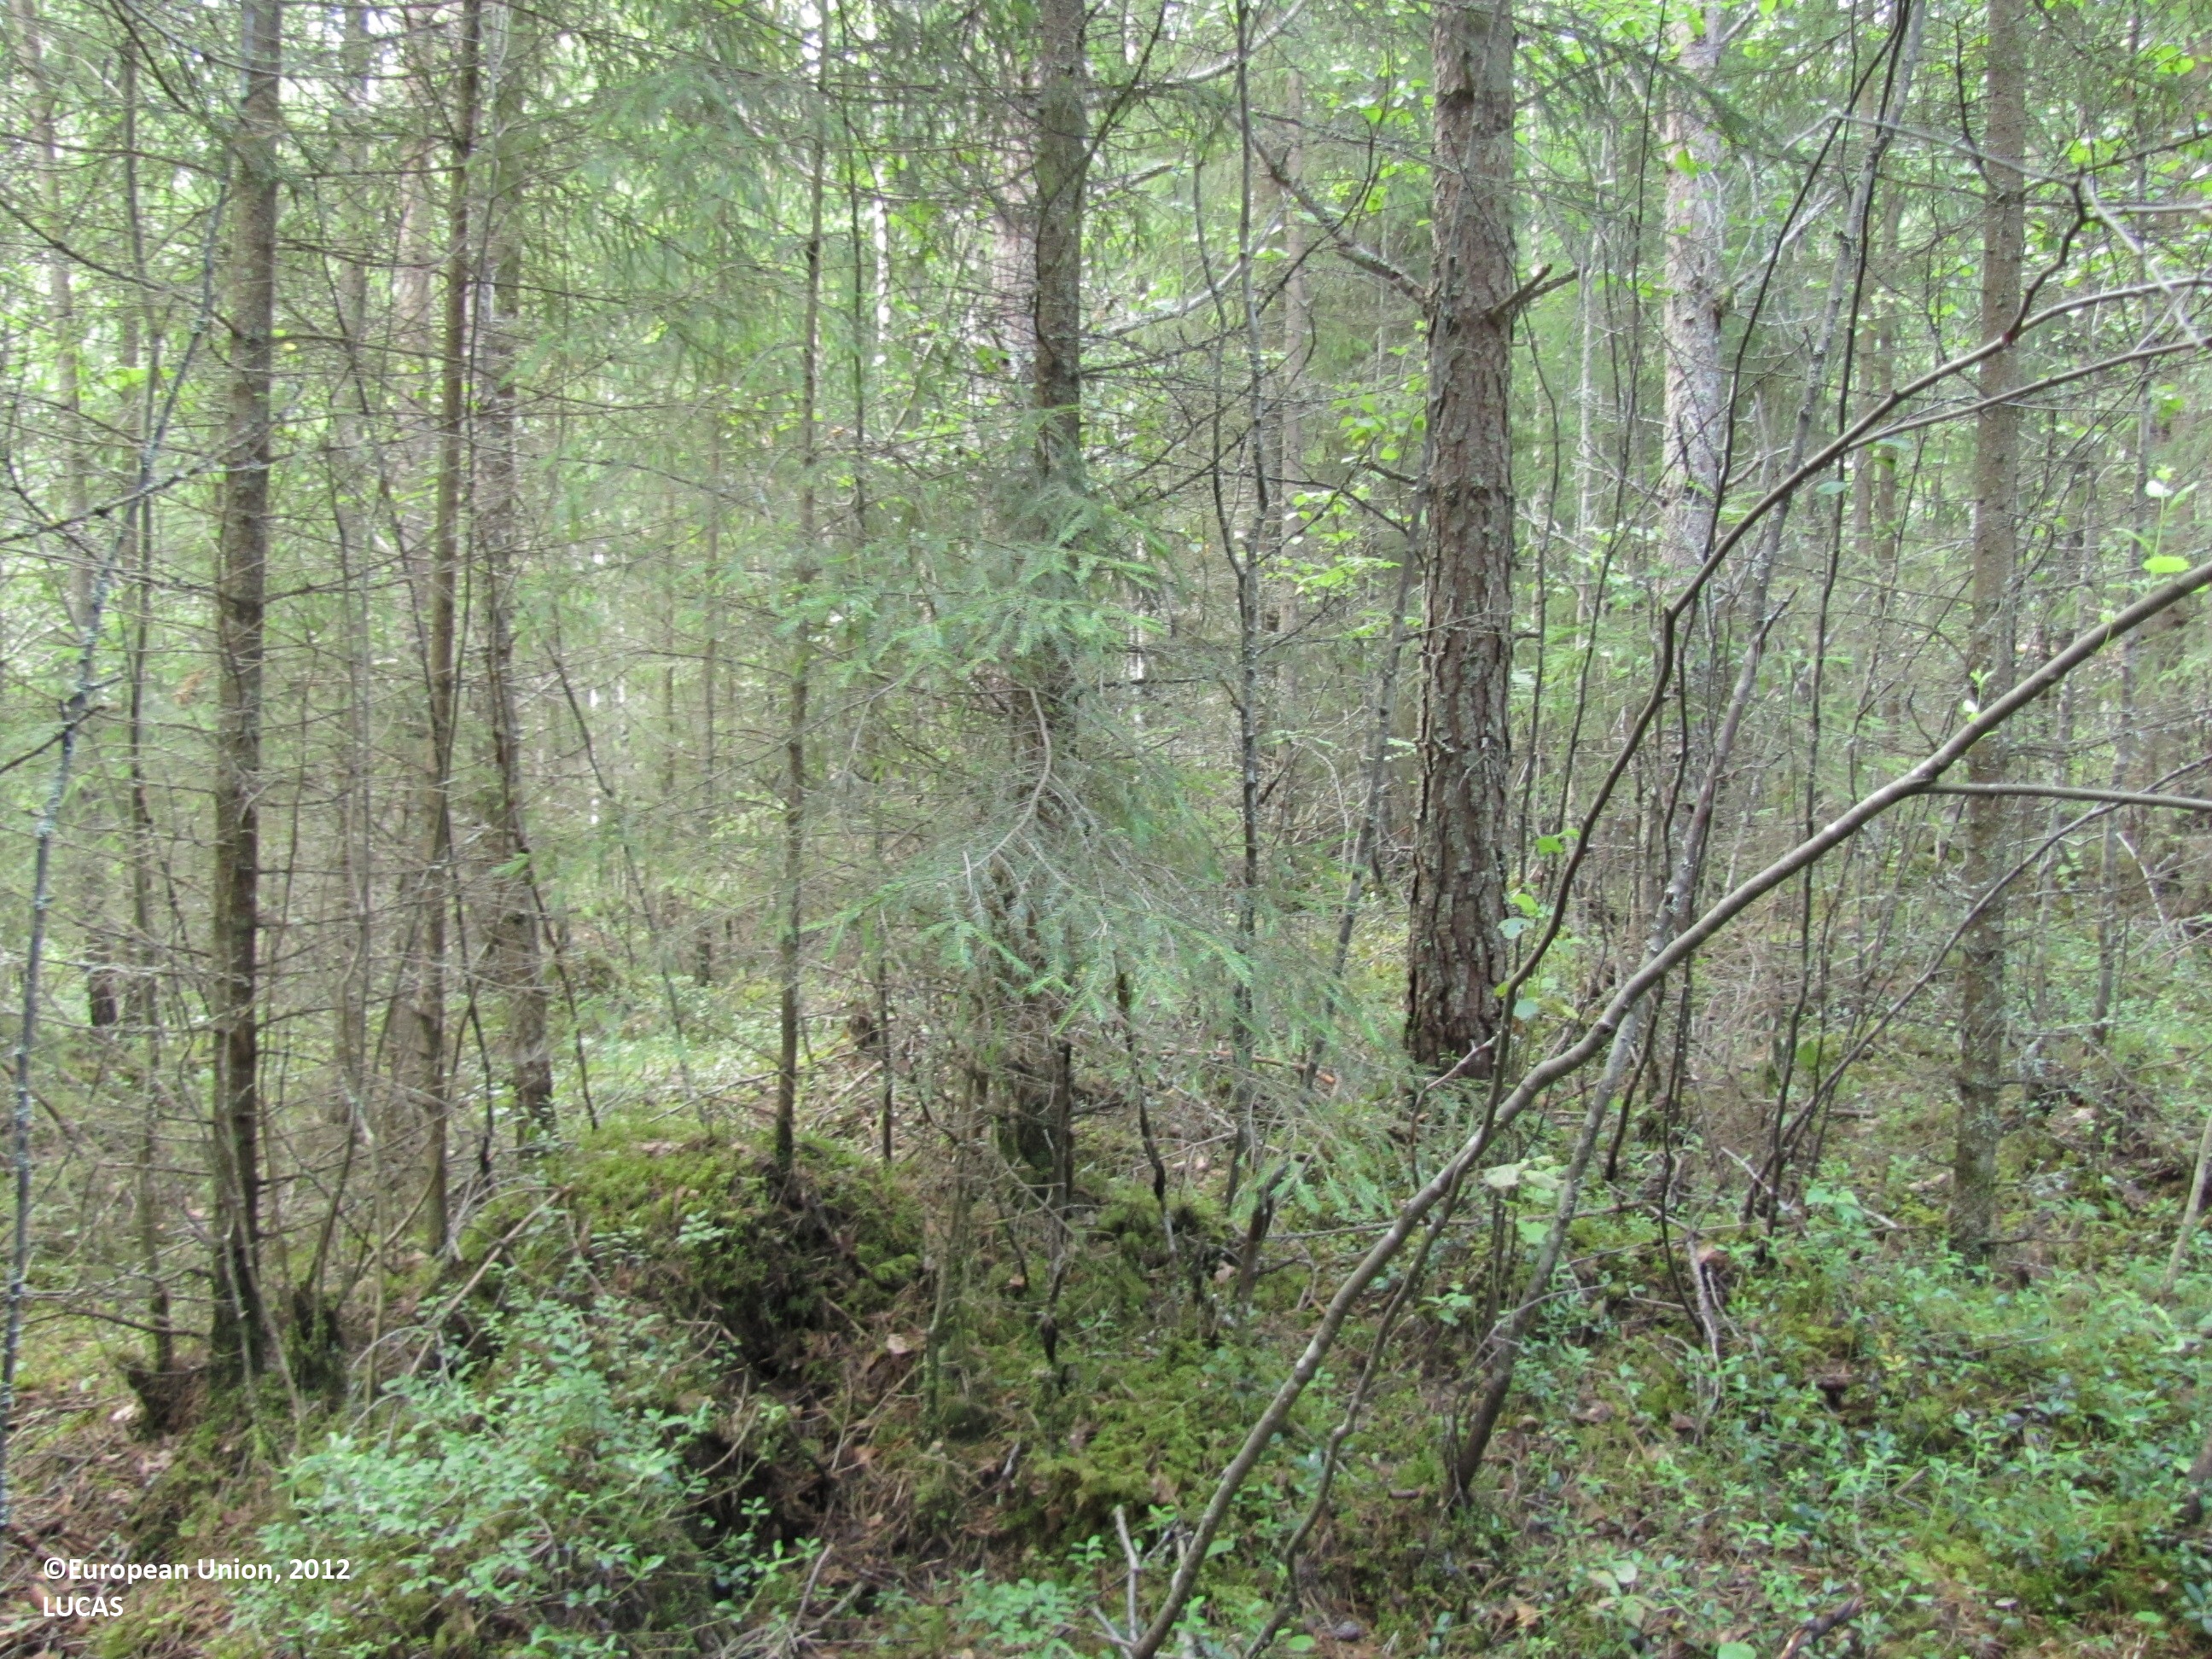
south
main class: Woodland
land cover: Spruce dominated mixed woodland
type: boreal forest
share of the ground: > 75 %
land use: Forestry
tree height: > 5 m
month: July
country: FI
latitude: 62.0919
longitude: 23.3049
